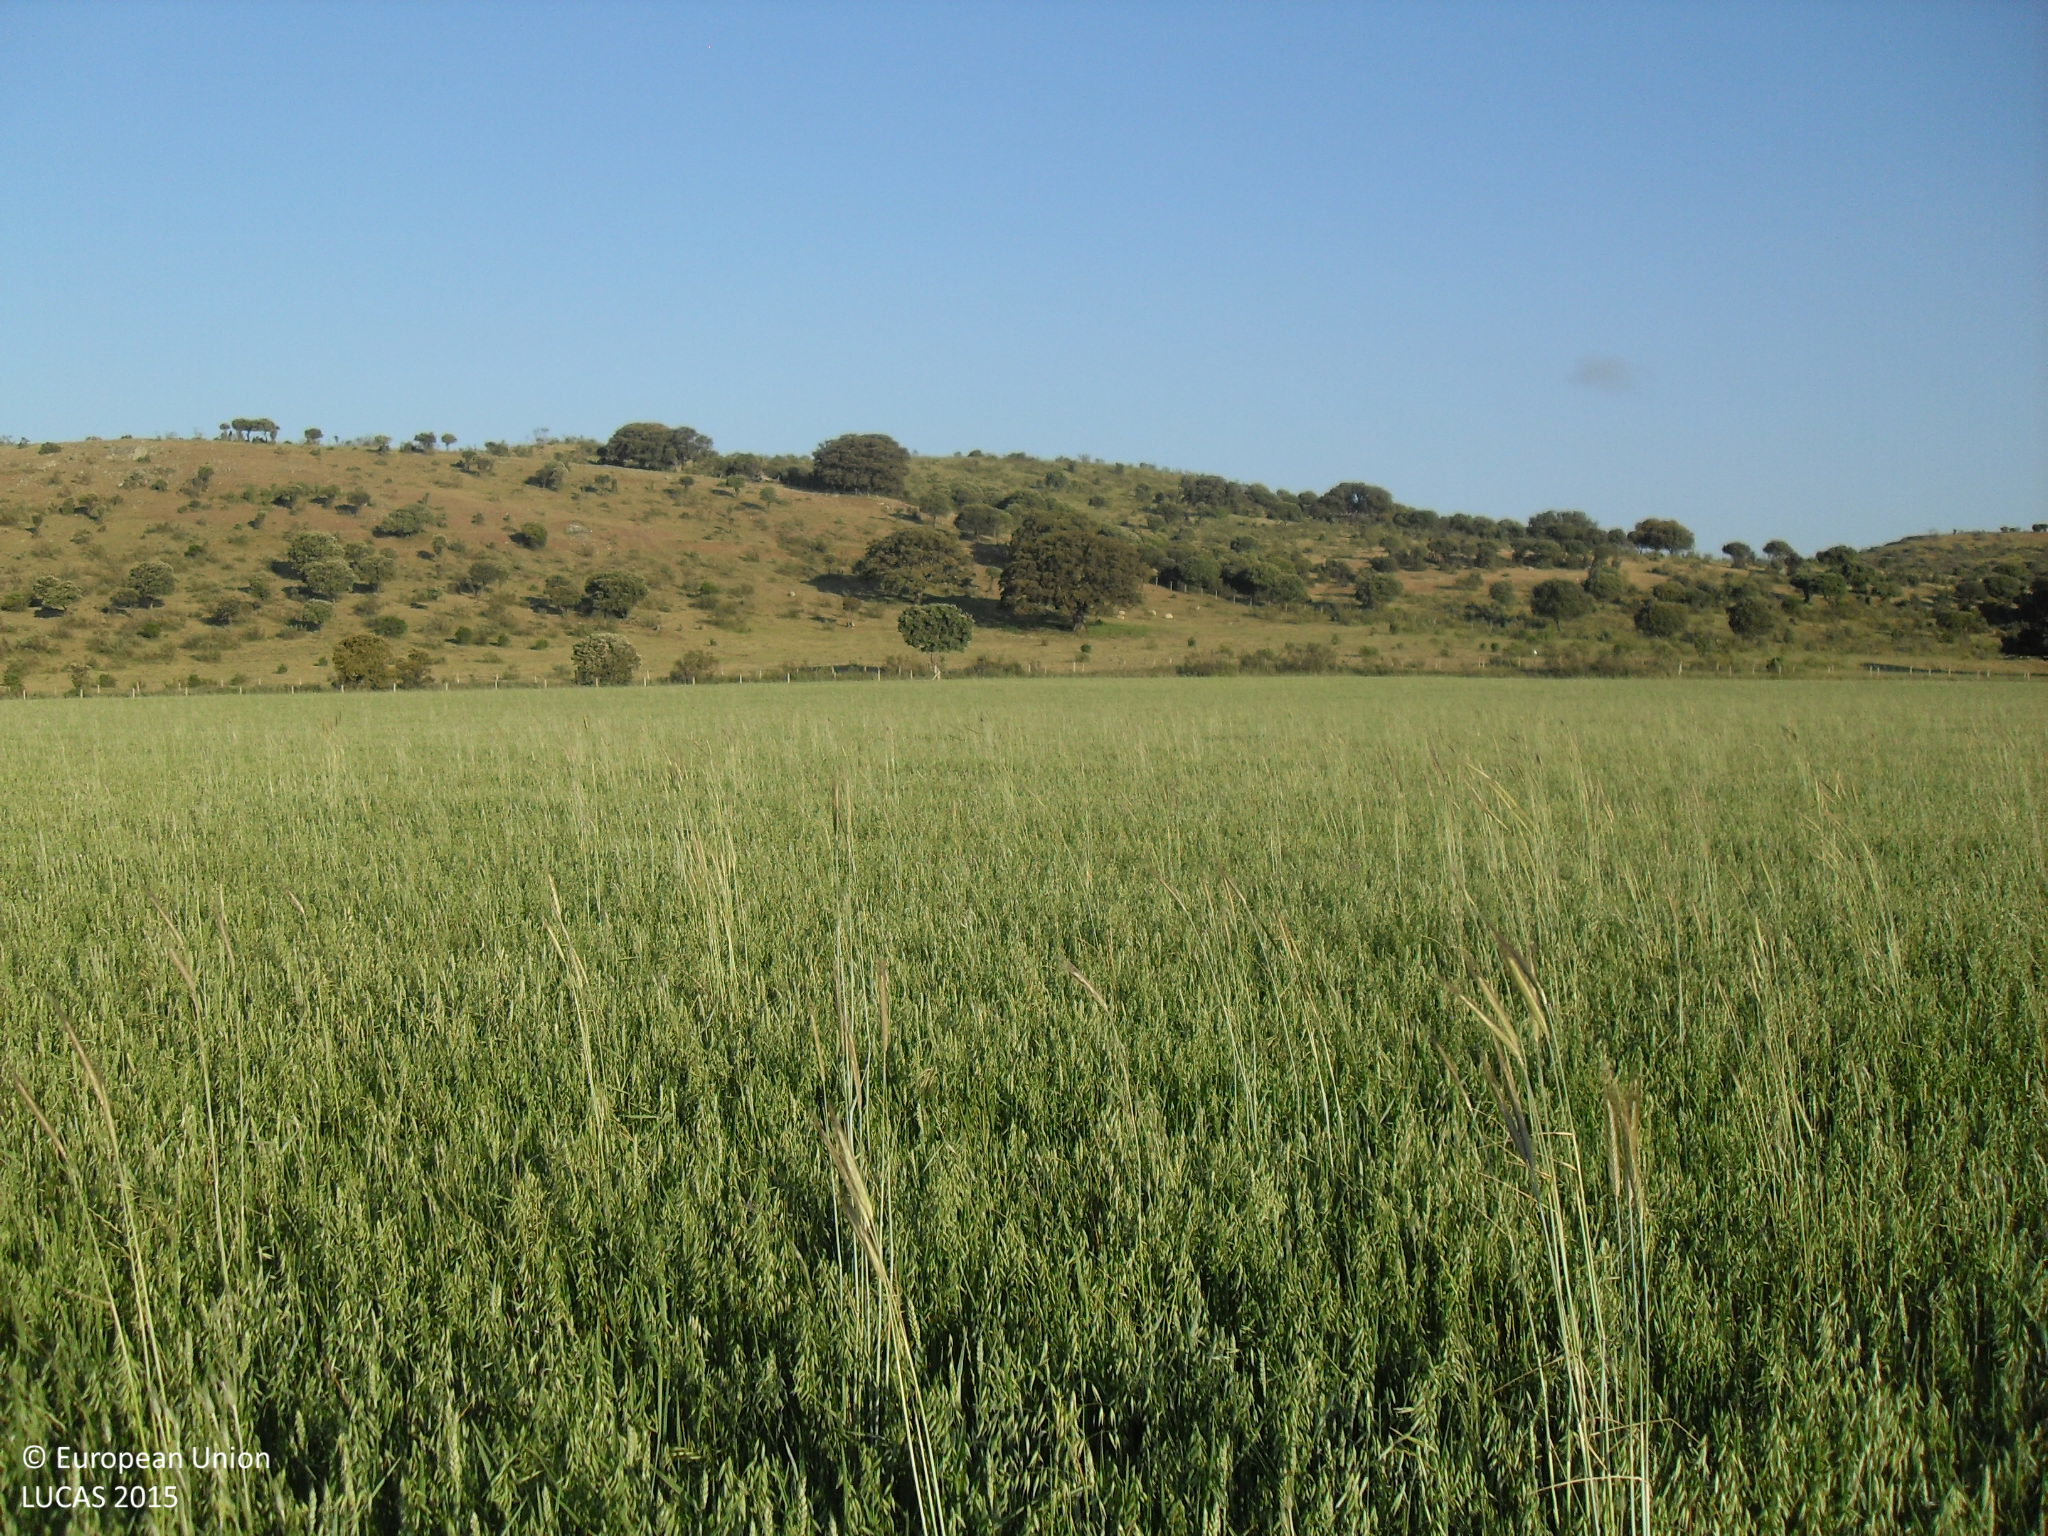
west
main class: Cropland
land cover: Oats
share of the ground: > 75 %
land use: Agriculture (excluding fallow land and kitchen gardens)
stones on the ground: < 10 %
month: May
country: ES
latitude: 40.7391
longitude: -5.5974
